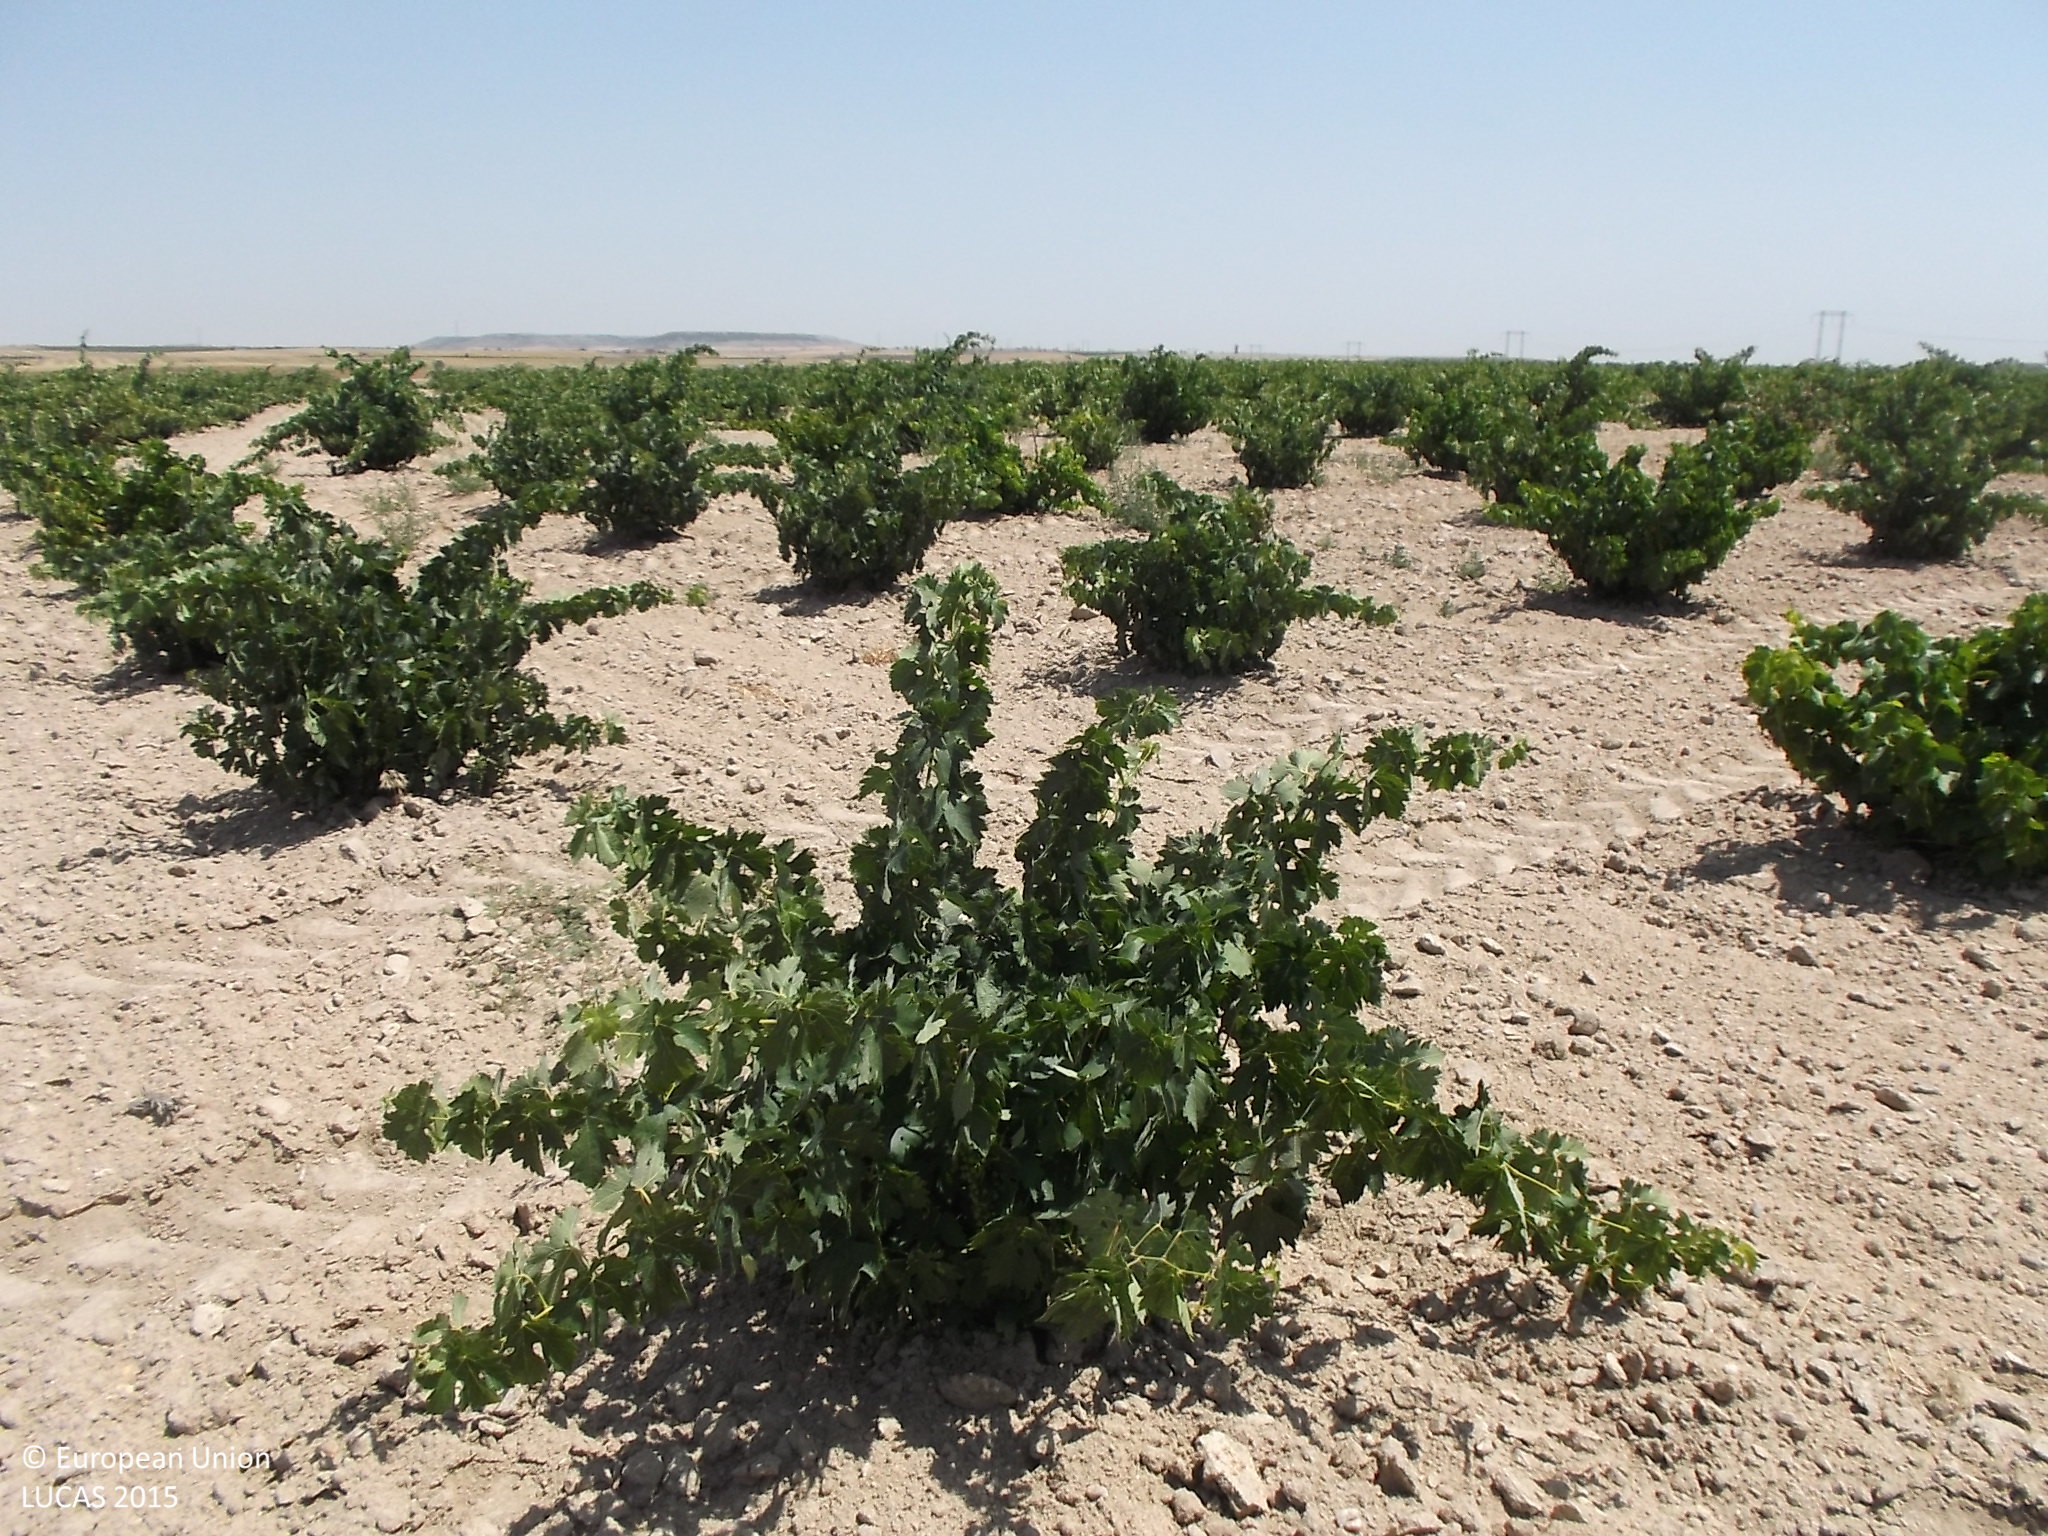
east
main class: Cropland
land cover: Vineyards
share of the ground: 10 - 25 %
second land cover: Other bare soil
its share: > 75 %
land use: Agriculture (excluding fallow land and kitchen gardens)
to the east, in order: Vineyards; Other bare soil; Vineyards
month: July
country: ES
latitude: 41.5544
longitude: -5.3173
